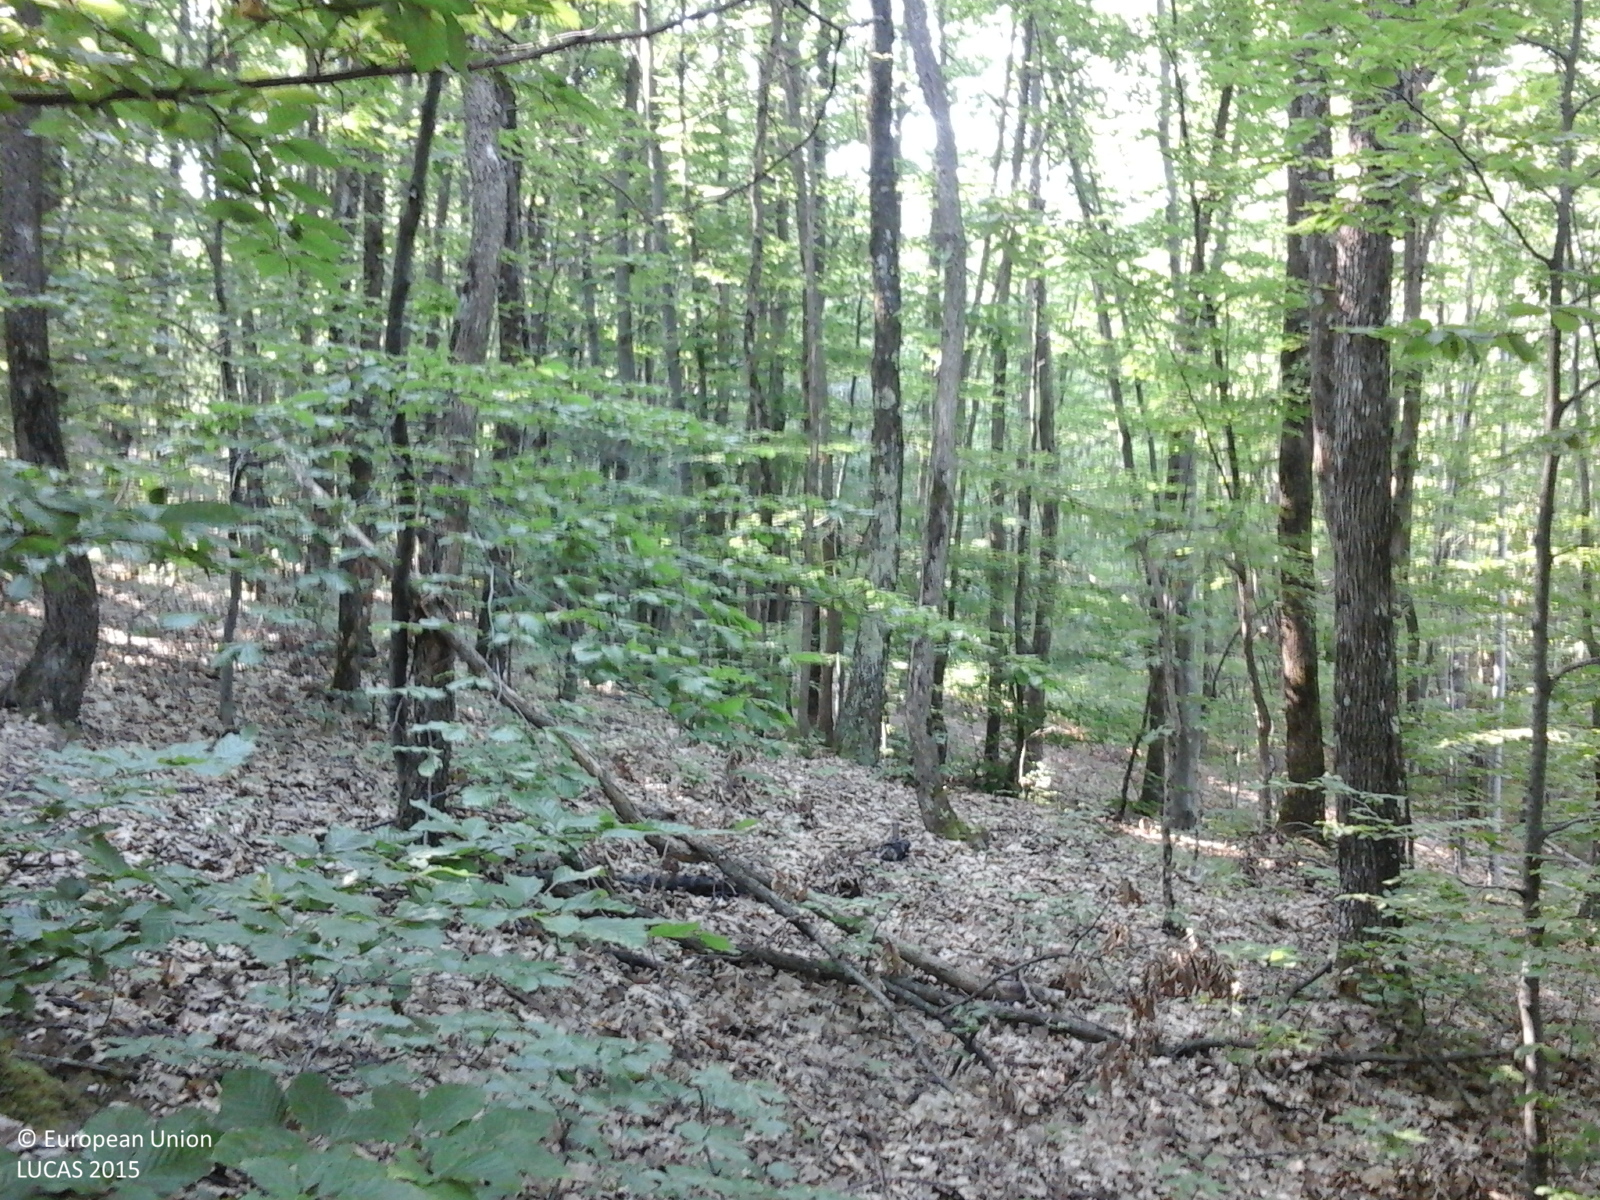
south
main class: Woodland
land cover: Broadleaved woodland
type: acidophilous oak and oak-birch forest
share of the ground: > 75 %
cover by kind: broadleaved forest trees 100 %
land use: Forestry
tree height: > 5 m
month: July
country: RO
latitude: 44.9668
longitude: 24.6715
